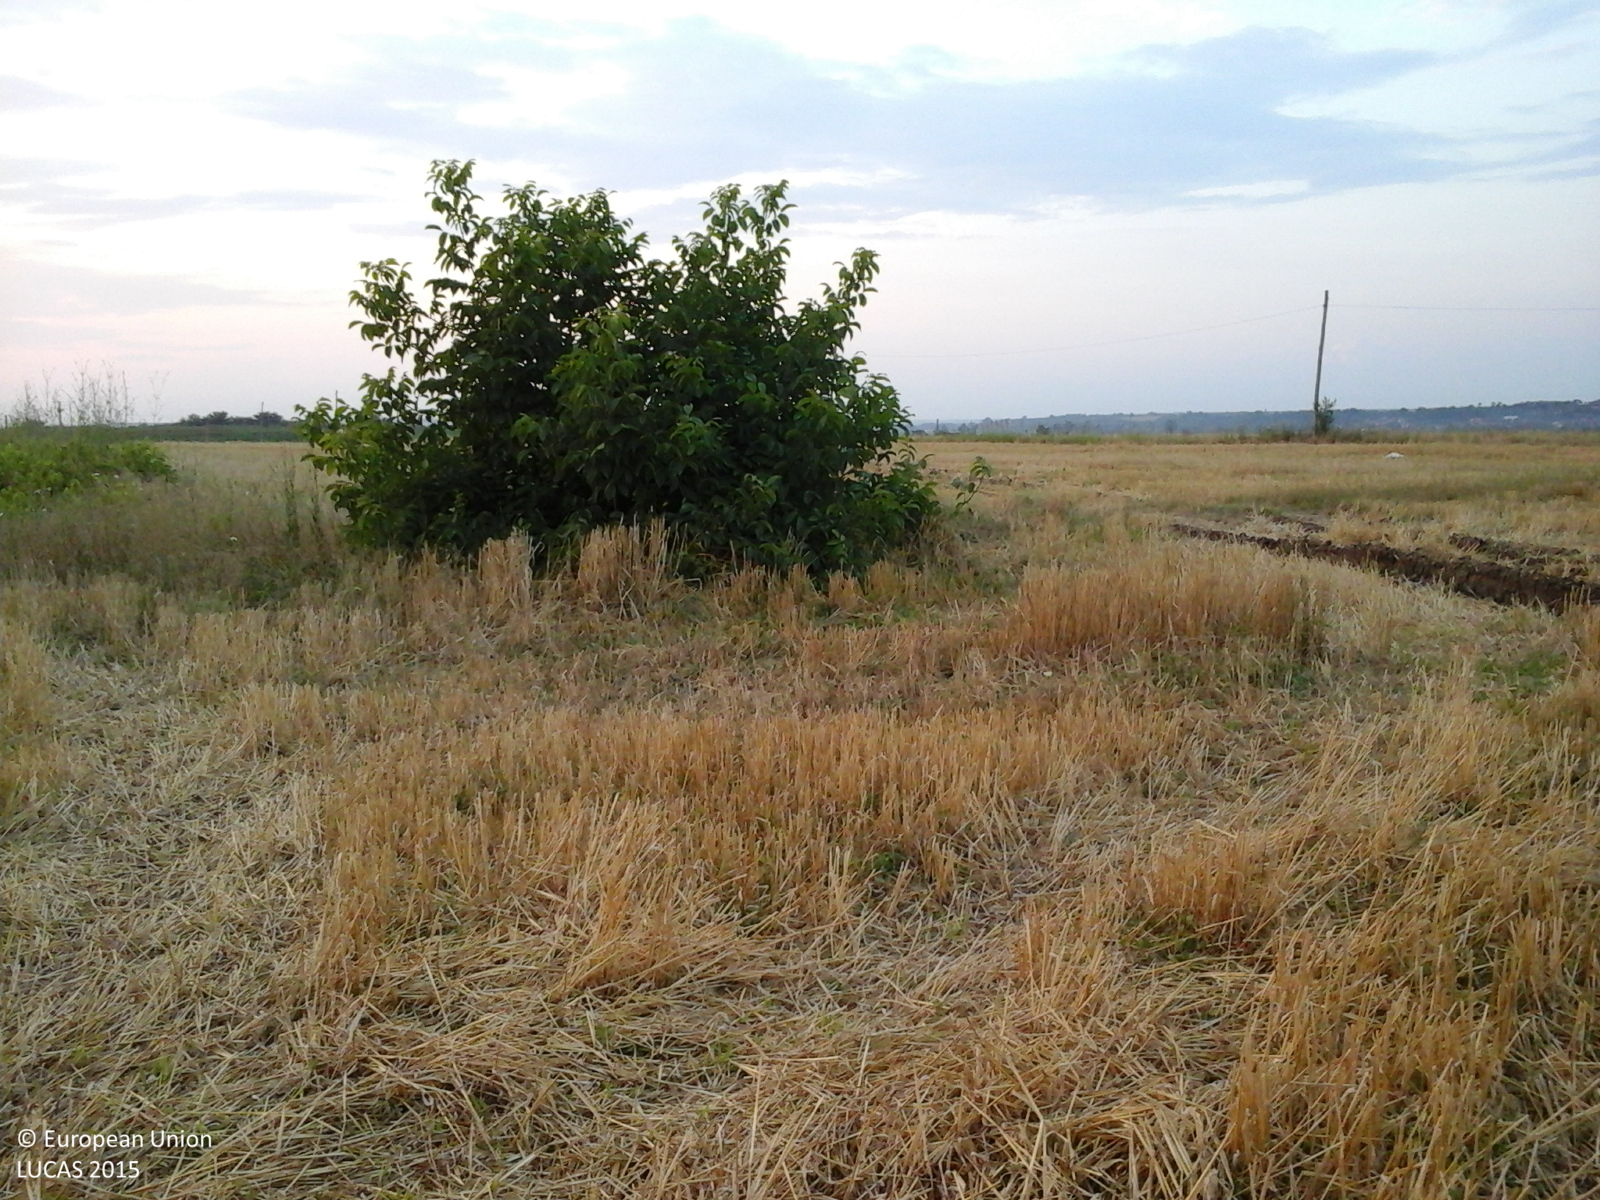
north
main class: Cropland
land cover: Common wheat
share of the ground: < 10 %
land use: Agriculture (excluding fallow land and kitchen gardens)
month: July
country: RO
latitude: 43.8283
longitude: 25.4411
